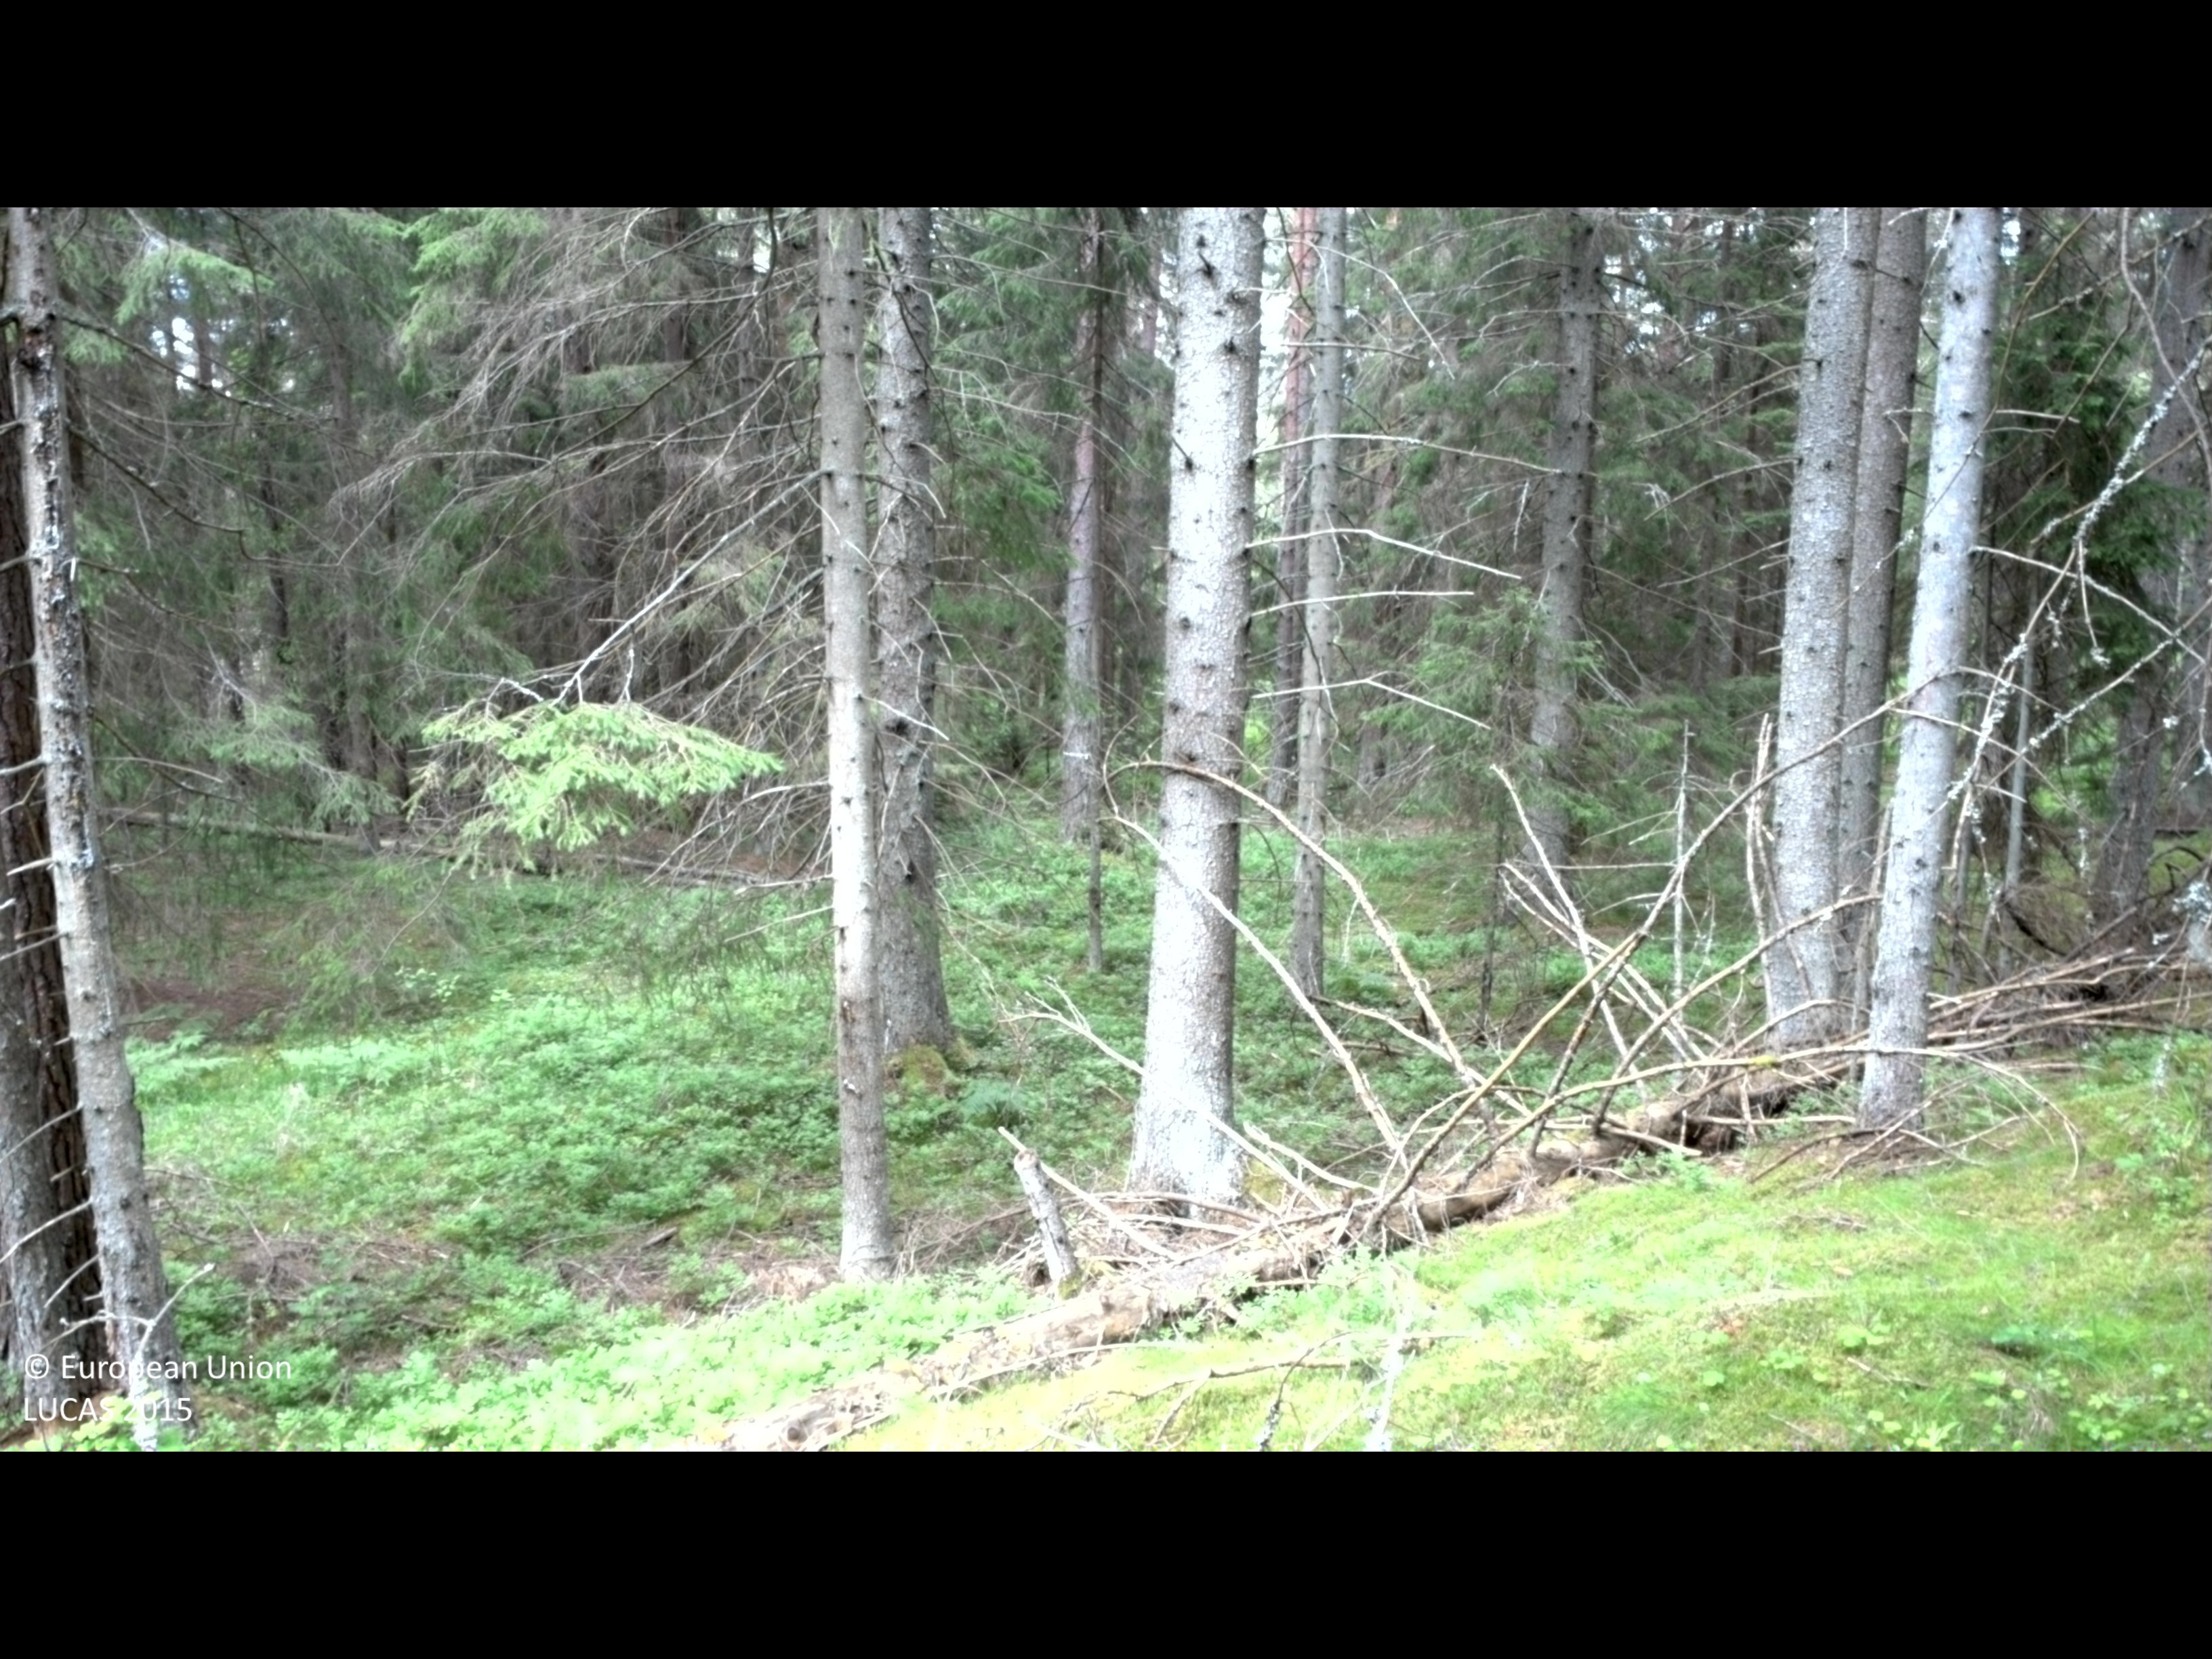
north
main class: Woodland
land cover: Spruce dominated coniferous woodland
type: boreal forest
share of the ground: 50 - 75 %
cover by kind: coniferous forest trees 65 %, shrubs 15 %, lichens and mosses 15 %, herbaceous plants 5 %
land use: Forestry
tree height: > 5 m
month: June
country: SE
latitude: 58.0741
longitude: 16.6270
